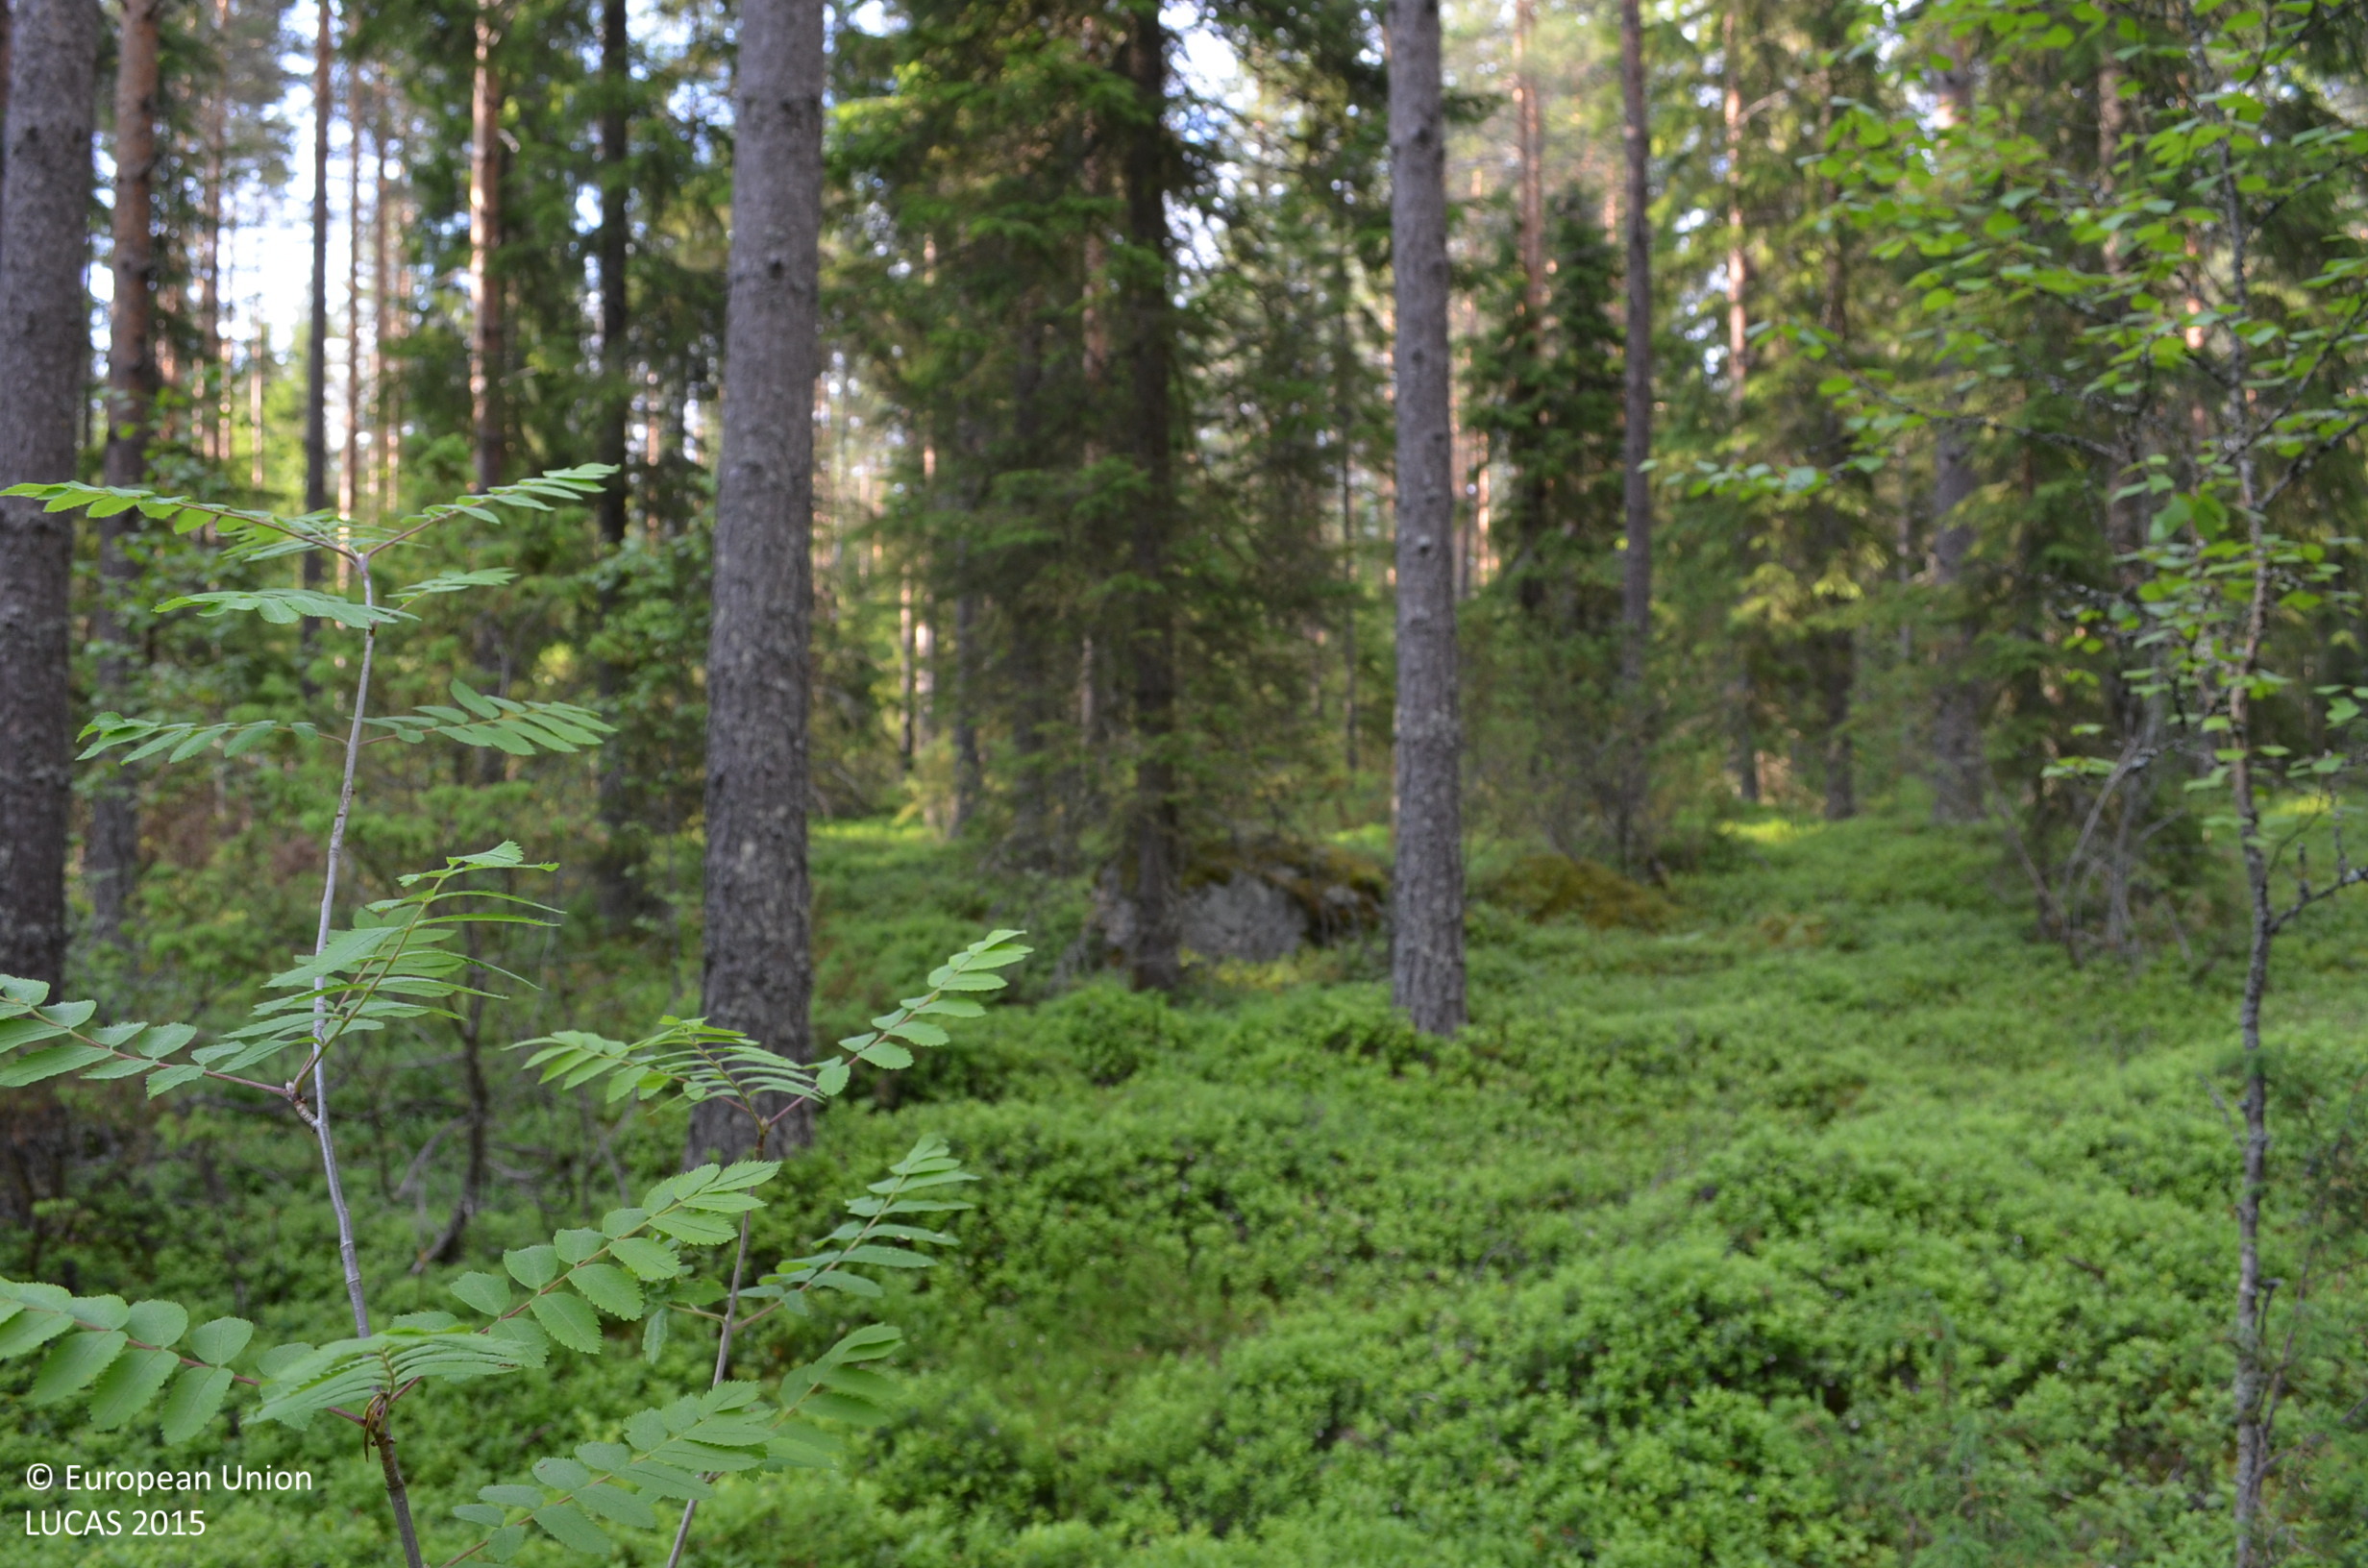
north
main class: Woodland
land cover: Pine dominated coniferous woodland
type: boreal forest
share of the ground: > 75 %
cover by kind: coniferous forest trees 70 %, shrubs 25 %, broadleaved forest trees 5 %
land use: Forestry
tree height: > 5 m
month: July
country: FI
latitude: 62.2825
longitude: 23.4275
